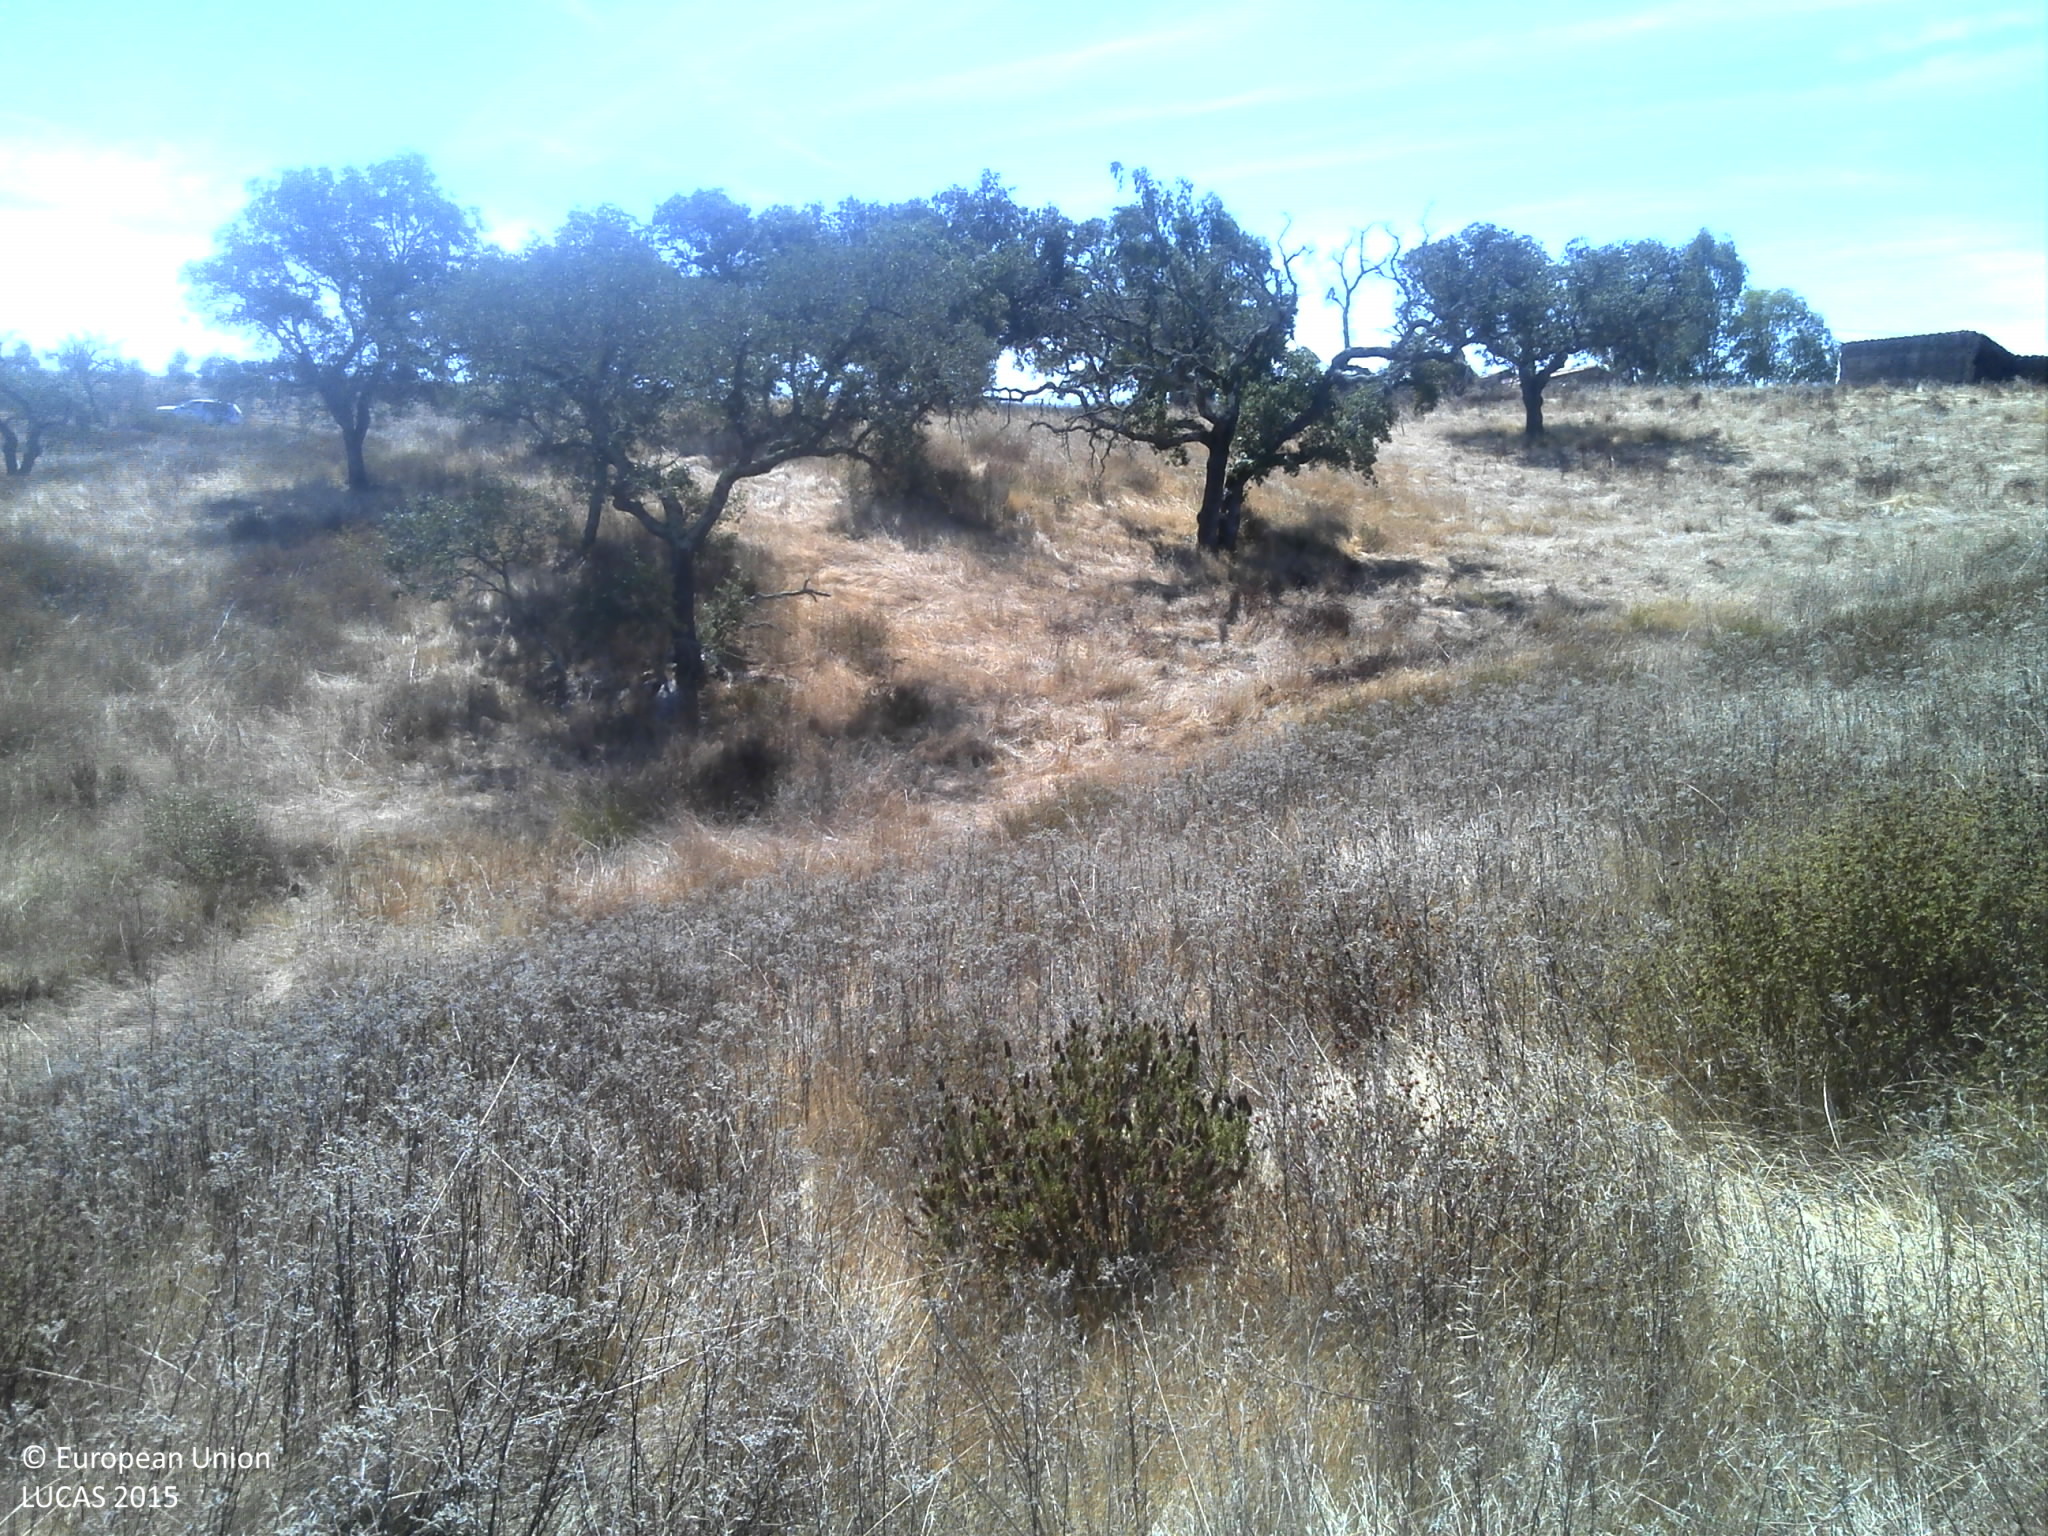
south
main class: Grassland
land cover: Grassland without tree/shrub cover
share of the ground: > 75 %
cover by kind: herbaceous plants 75 %, unconsolidated bare surface 25 %
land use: Agriculture (excluding fallow land and kitchen gardens)
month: August
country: PT
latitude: 37.5247
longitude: -8.2327
